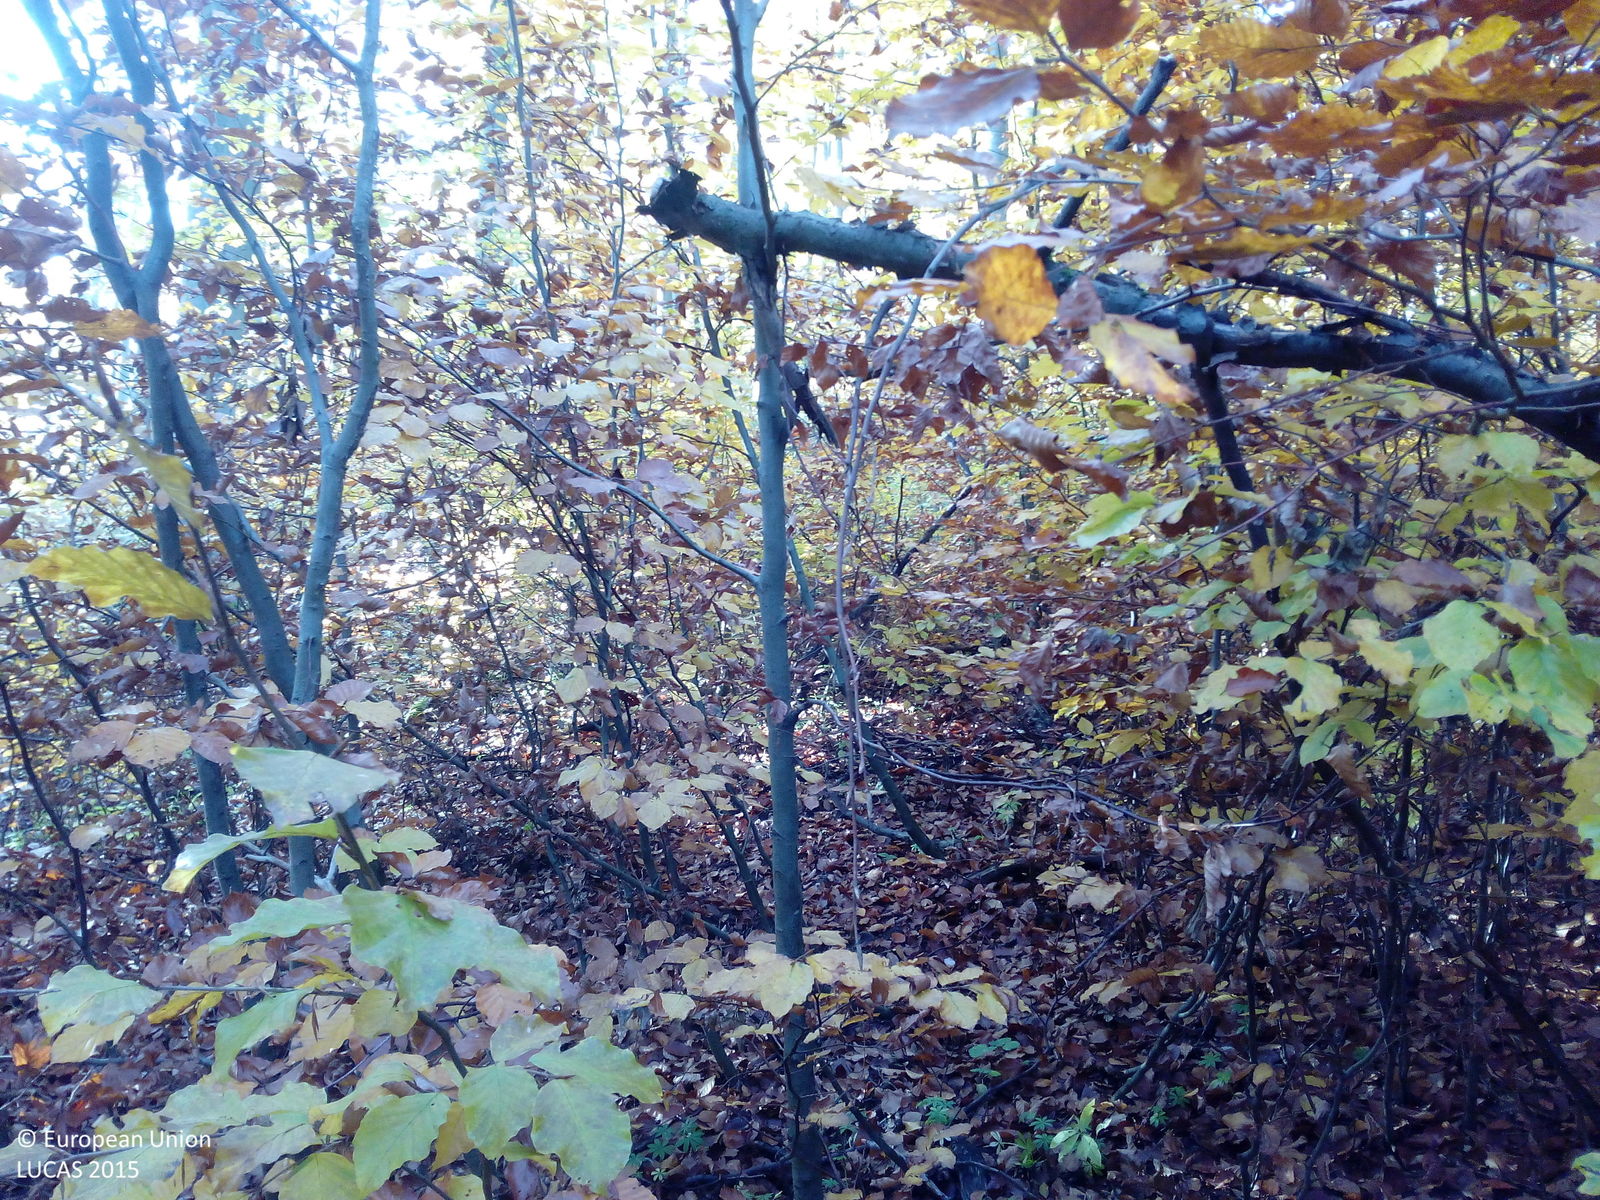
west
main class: Woodland
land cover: Broadleaved woodland
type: beech forest
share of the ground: > 75 %
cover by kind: broadleaved forest trees 85 %, unconsolidated bare surface 10 %, herbaceous plants 5 %
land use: Forestry
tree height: > 5 m
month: October
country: DE
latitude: 50.3281
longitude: 9.9579
